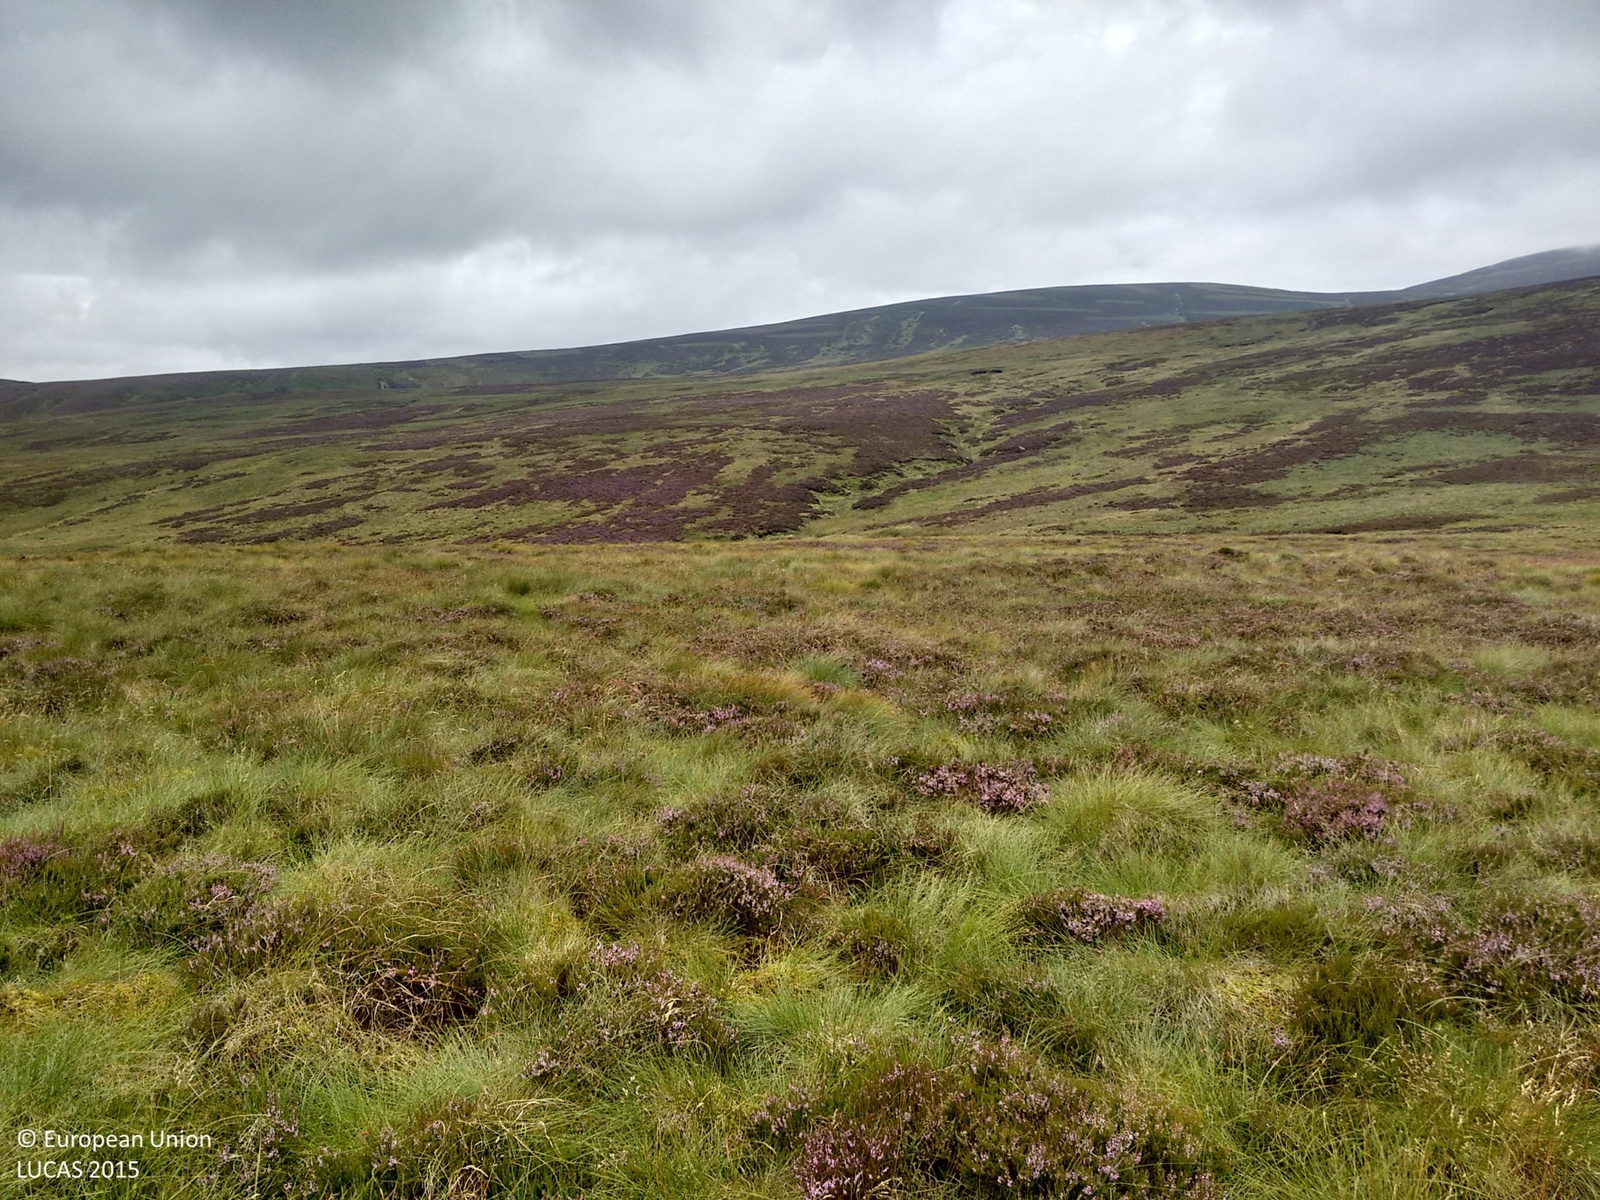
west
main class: Shrubland
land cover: Shrubland without tree cover
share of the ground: > 75 %
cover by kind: shrubs 70 %, herbaceous plants 30 %
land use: Agriculture (excluding fallow land and kitchen gardens)
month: August
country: GB
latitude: 56.9392
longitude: -2.6979
